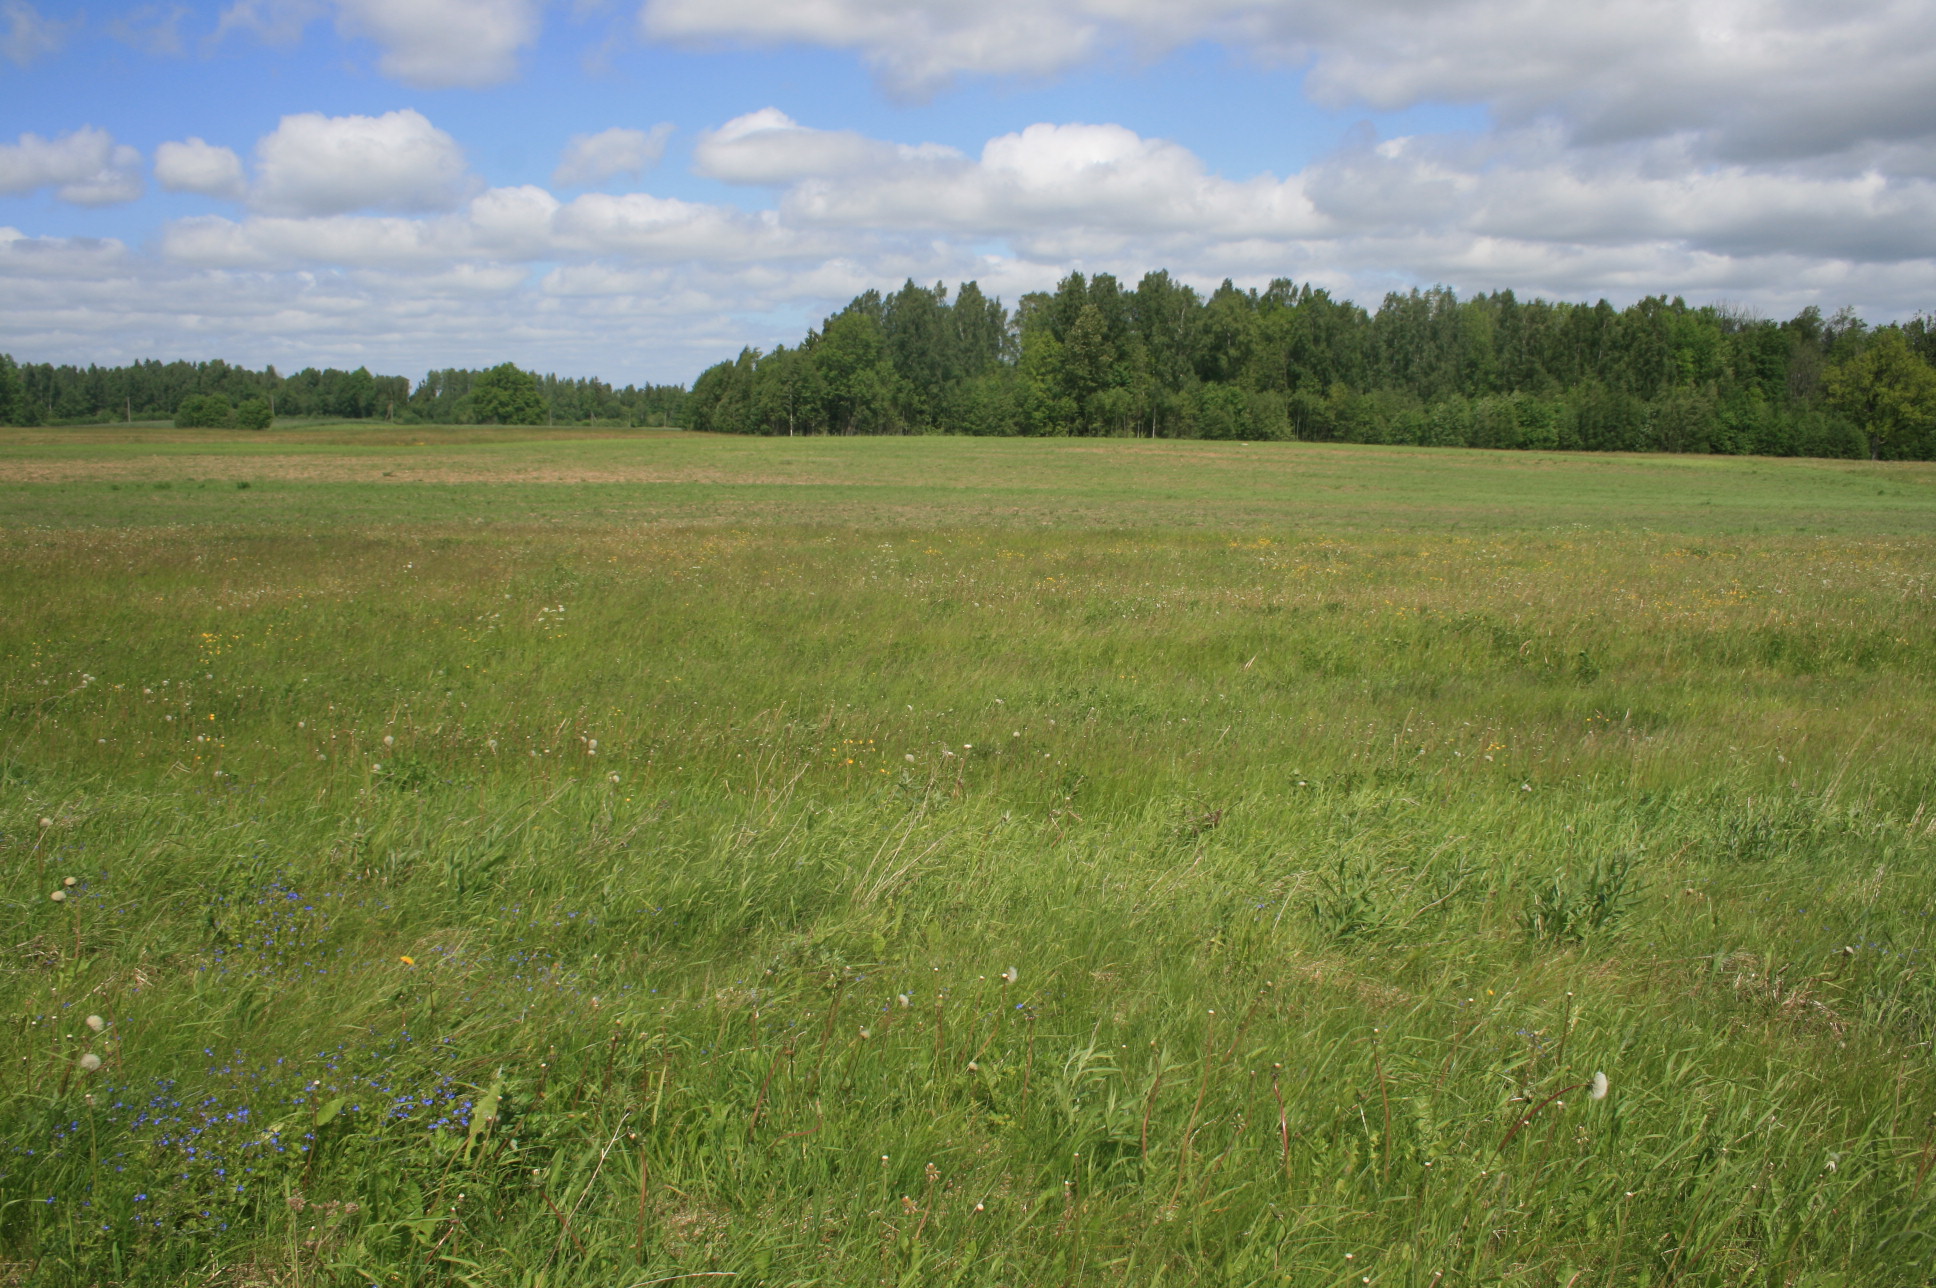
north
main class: Grassland
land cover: Grassland without tree/shrub cover
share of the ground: > 75 %
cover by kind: herbaceous plants 95 %, unconsolidated bare surface 5 %
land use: Agriculture (excluding fallow land and kitchen gardens)
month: June
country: LT
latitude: 56.0948
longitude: 22.3859
